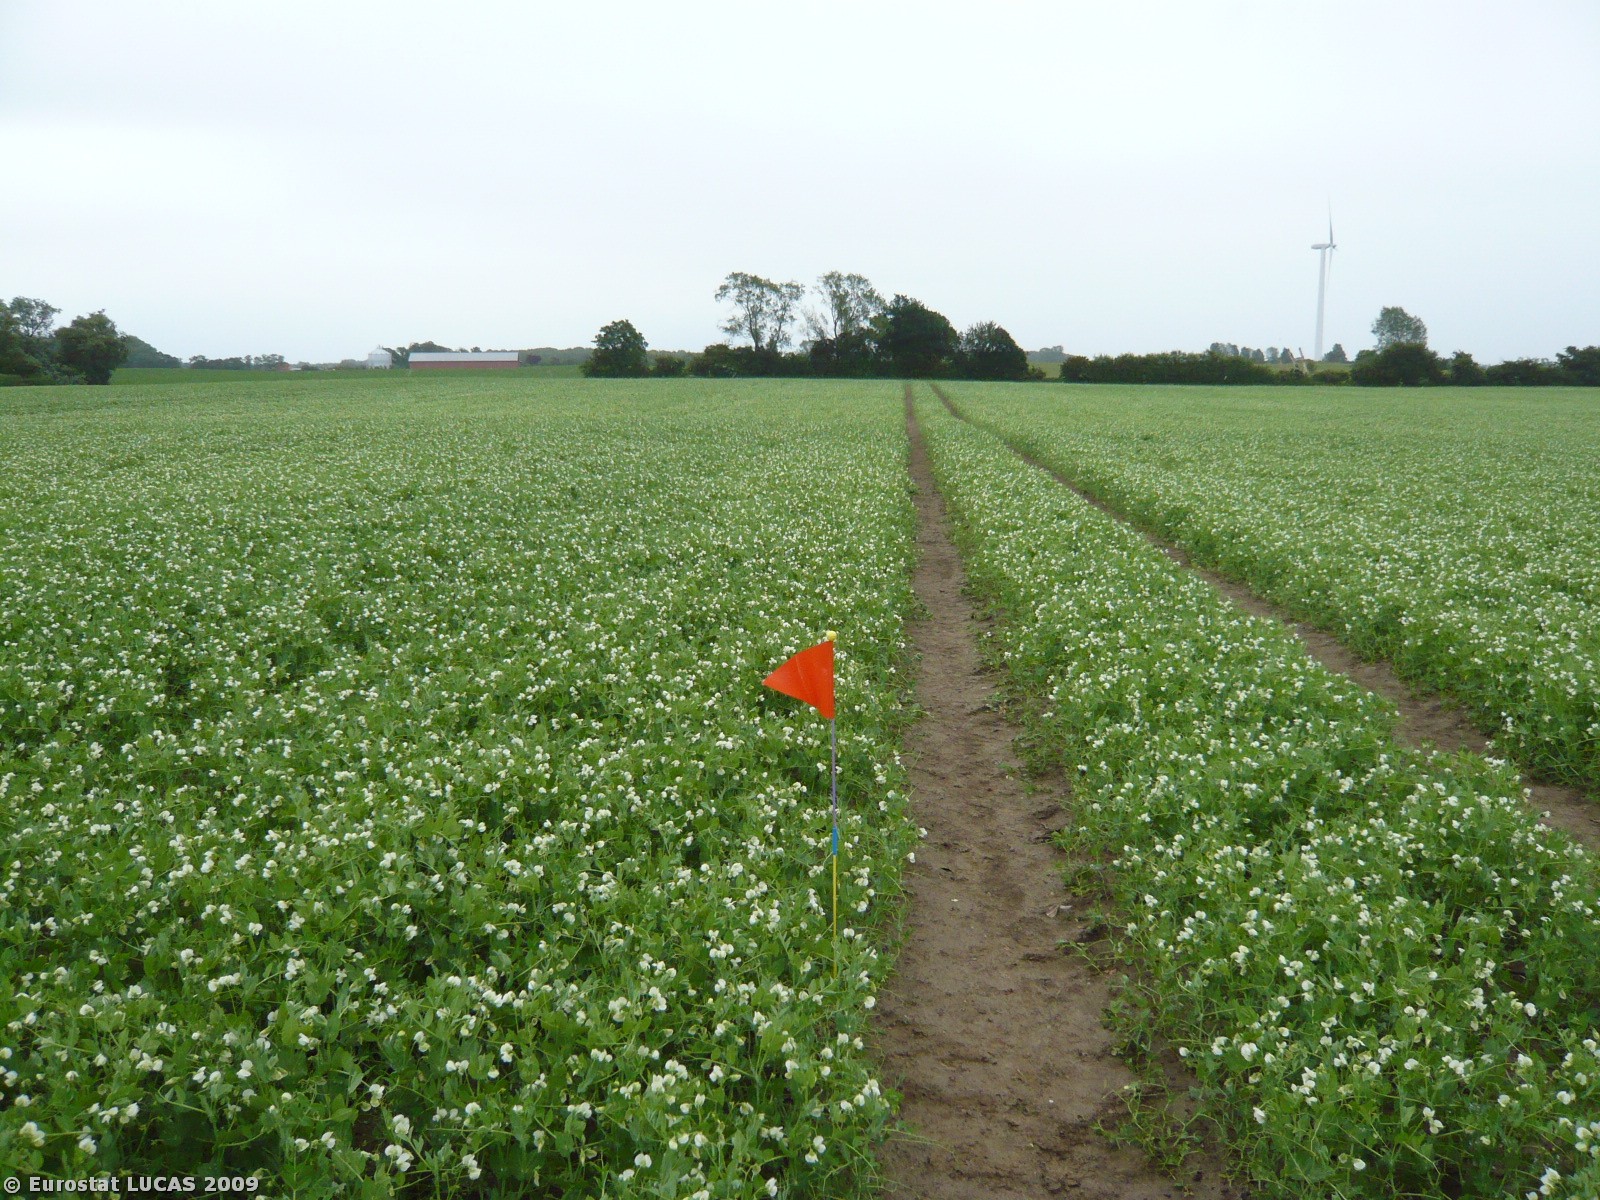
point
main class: Cropland
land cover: Dry pulses
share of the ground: > 75 %
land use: Agriculture (excluding fallow land and kitchen gardens)
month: June
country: DK
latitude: 54.8122
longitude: 11.5394
